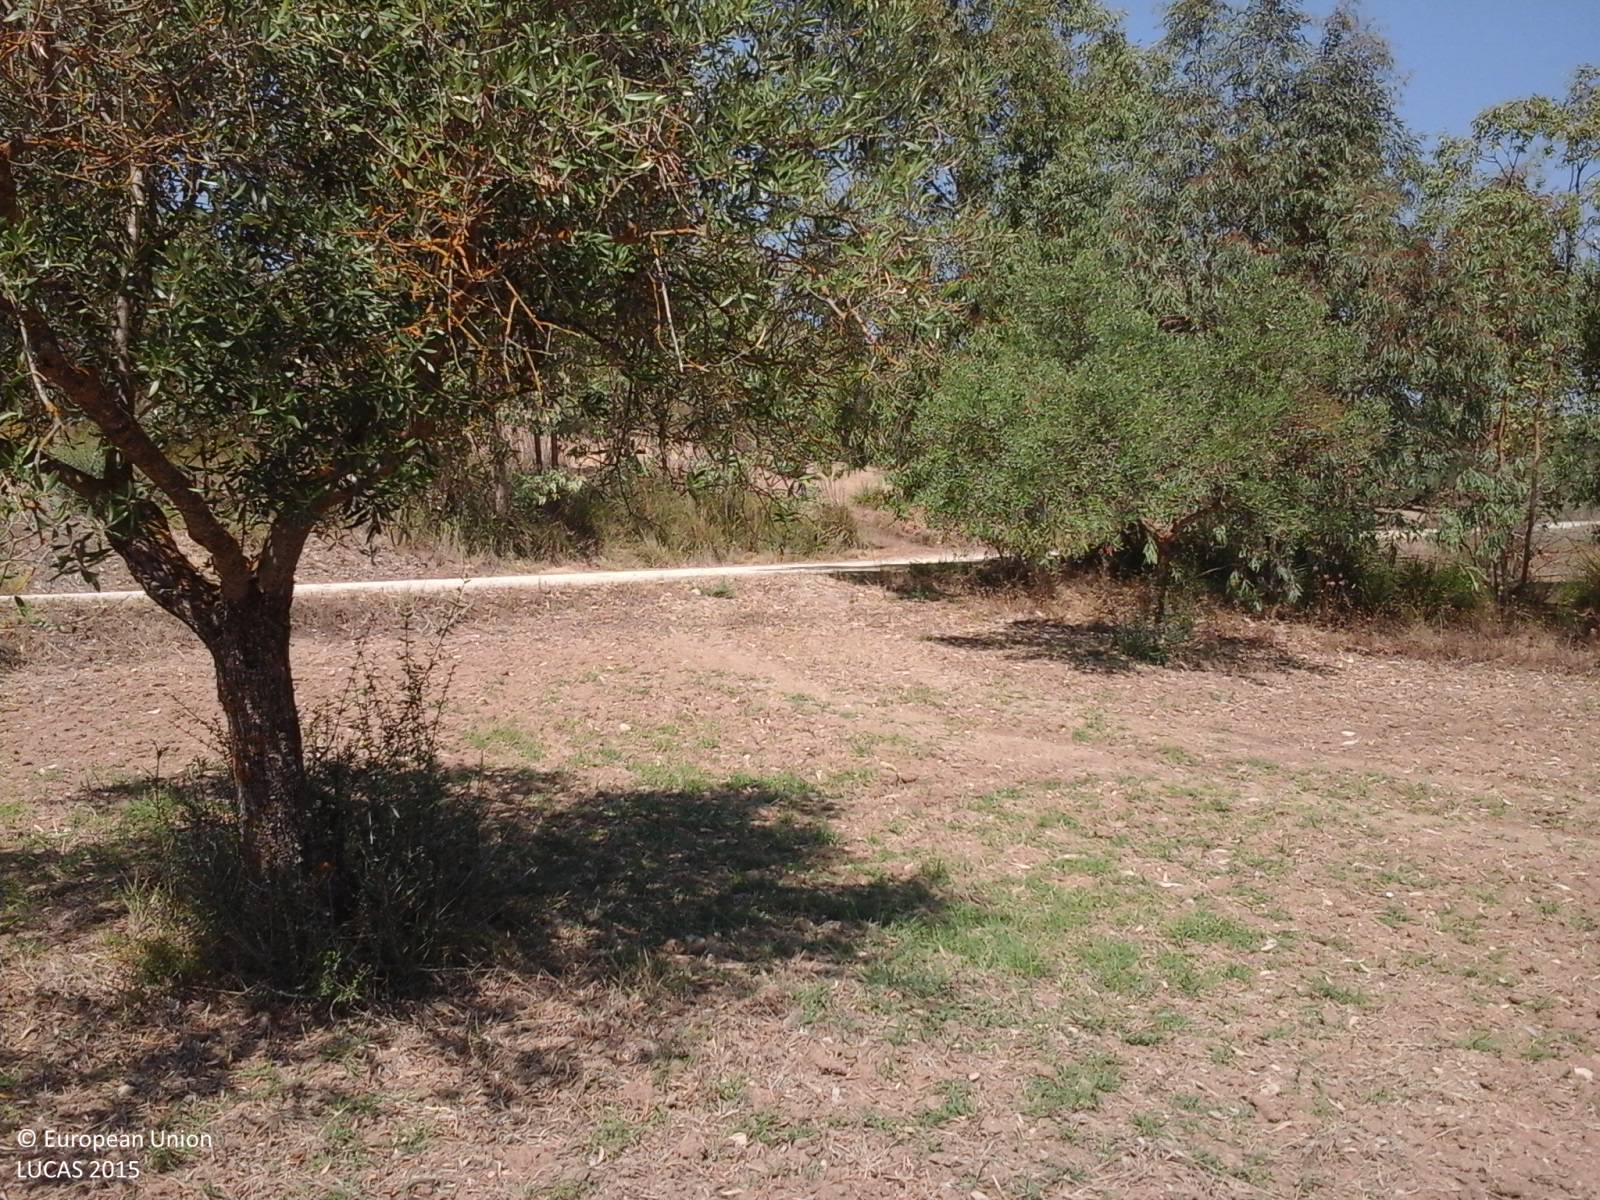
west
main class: Cropland
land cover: Olive groves
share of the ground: > 75 %
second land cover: Other bare soil
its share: > 75 %
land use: Agriculture (excluding fallow land and kitchen gardens)
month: July
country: IT
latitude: 39.6273
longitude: 8.8996
